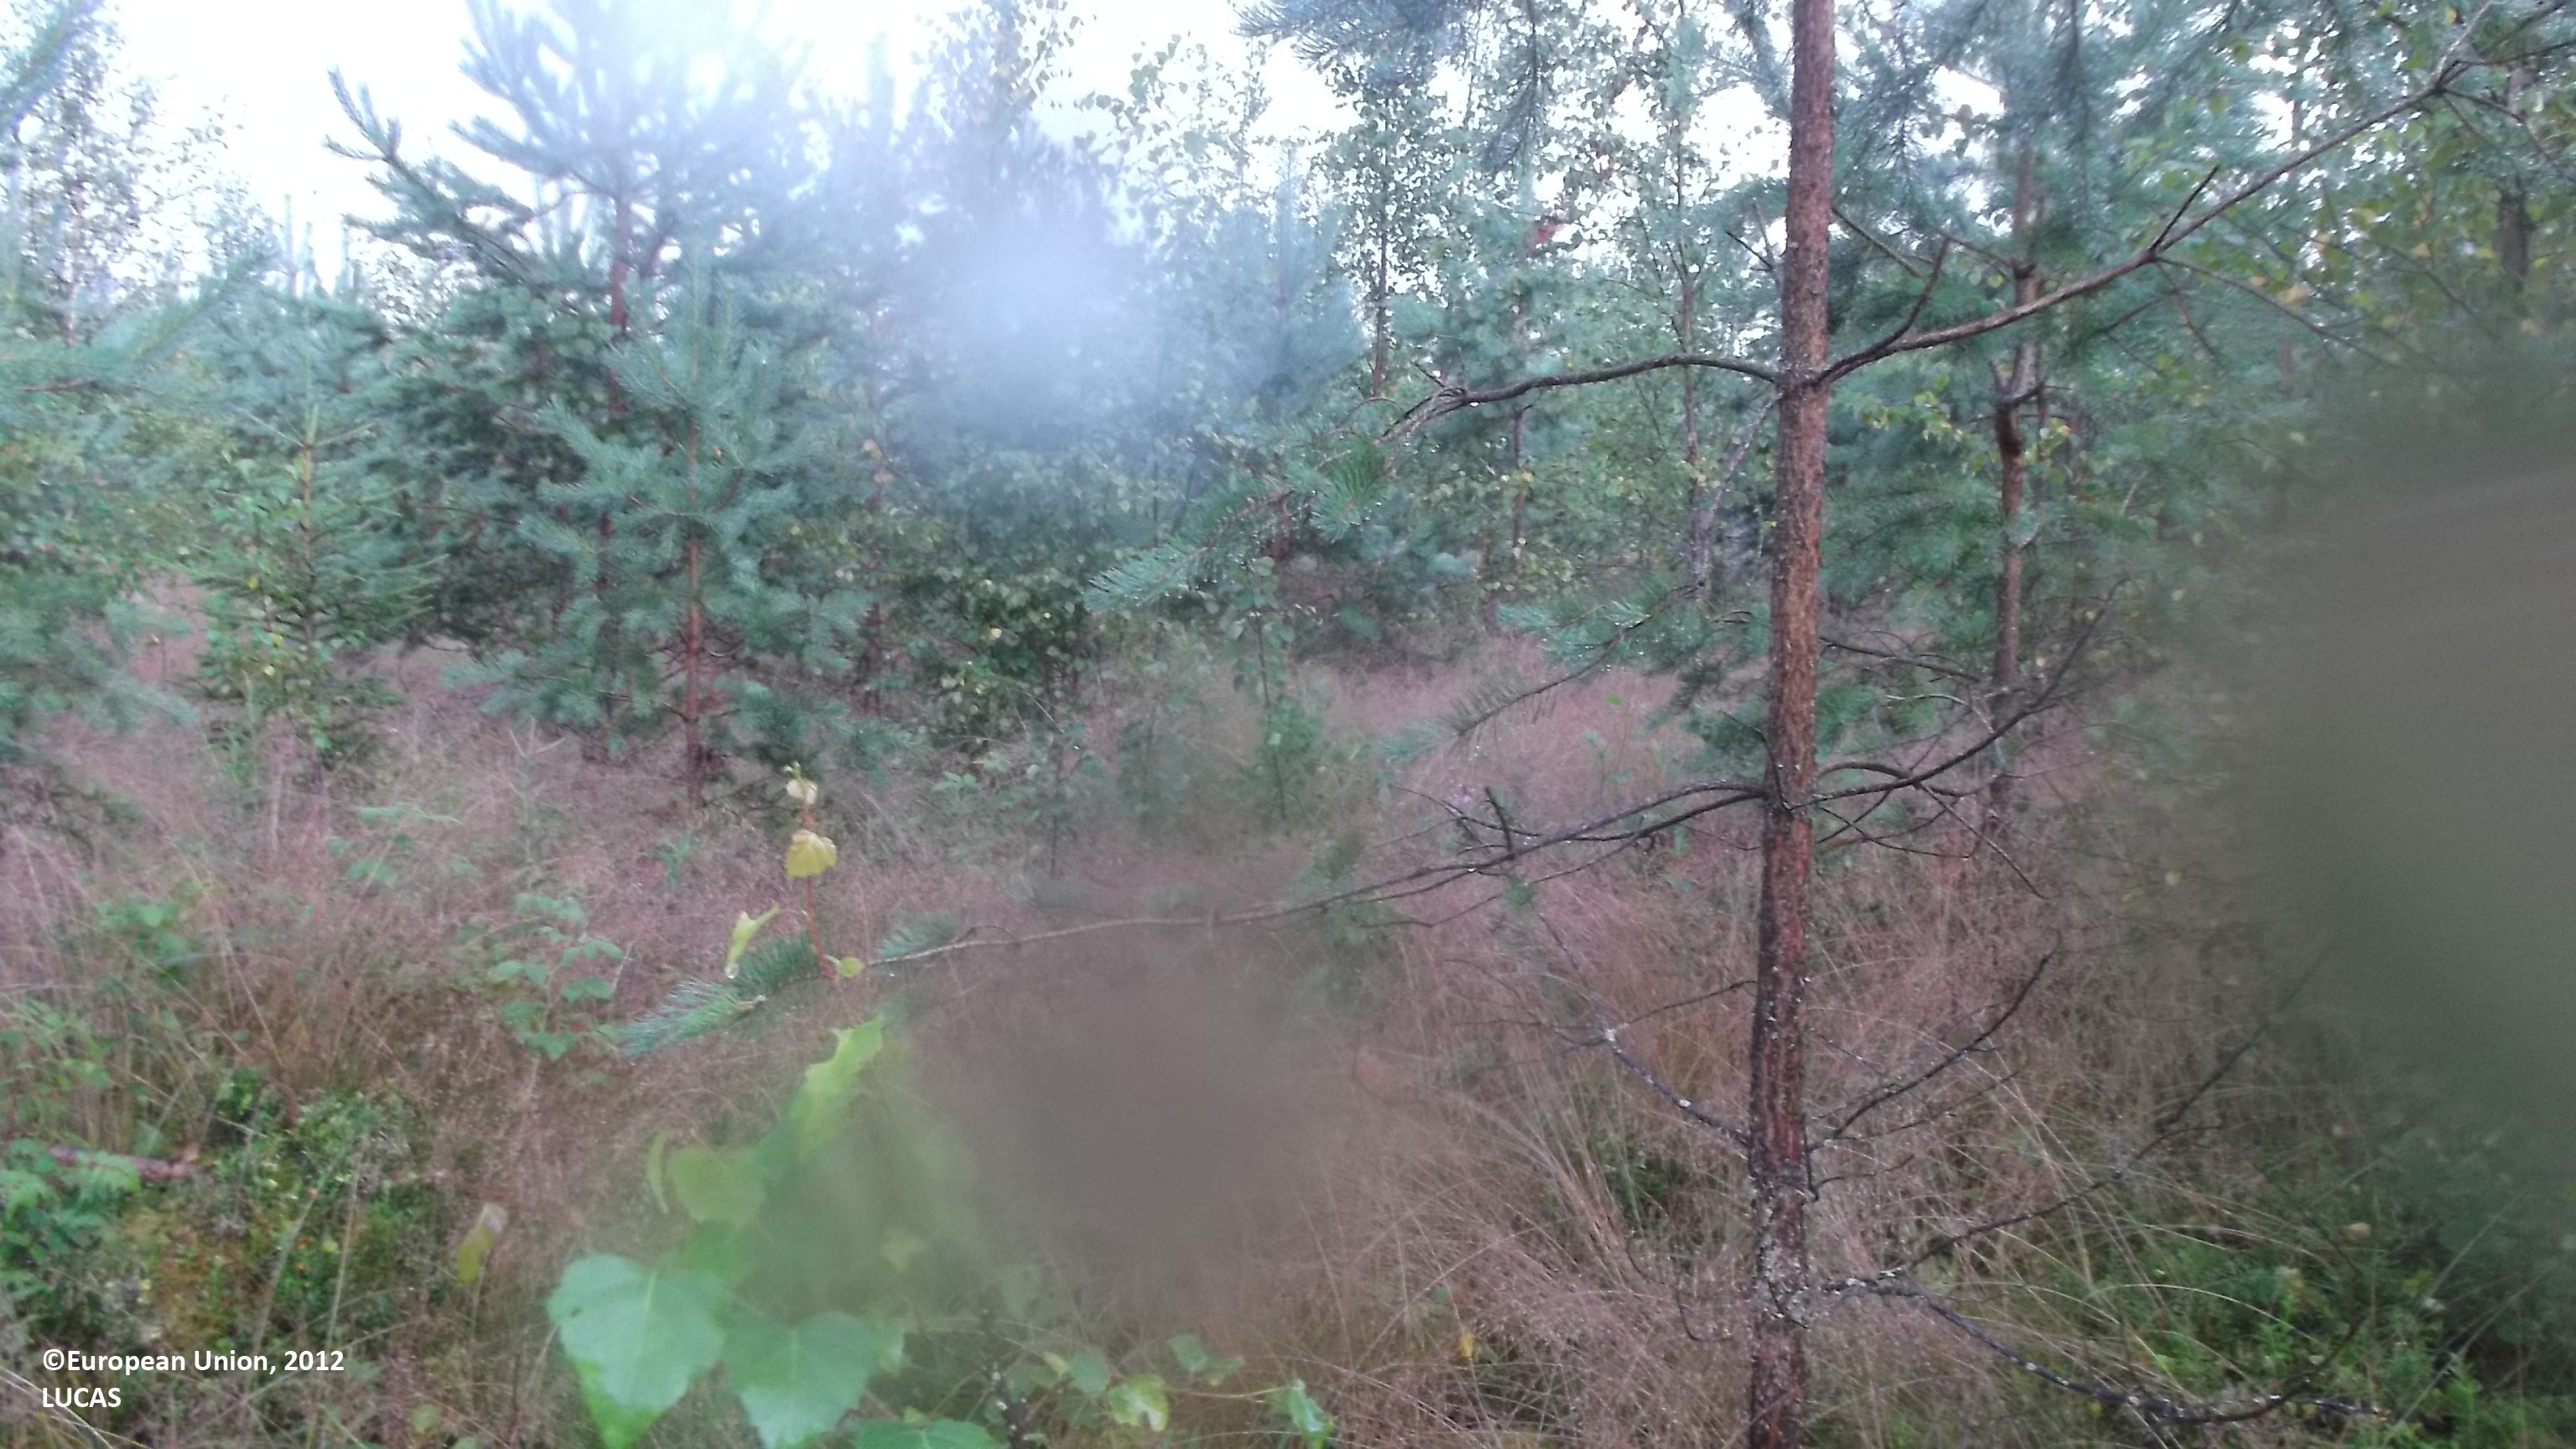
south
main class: Woodland
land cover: Other mixed woodland
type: boreal forest
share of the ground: 50 - 75 %
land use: Forestry
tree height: < 5 m
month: August
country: FI
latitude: 63.7413
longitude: 23.3264
